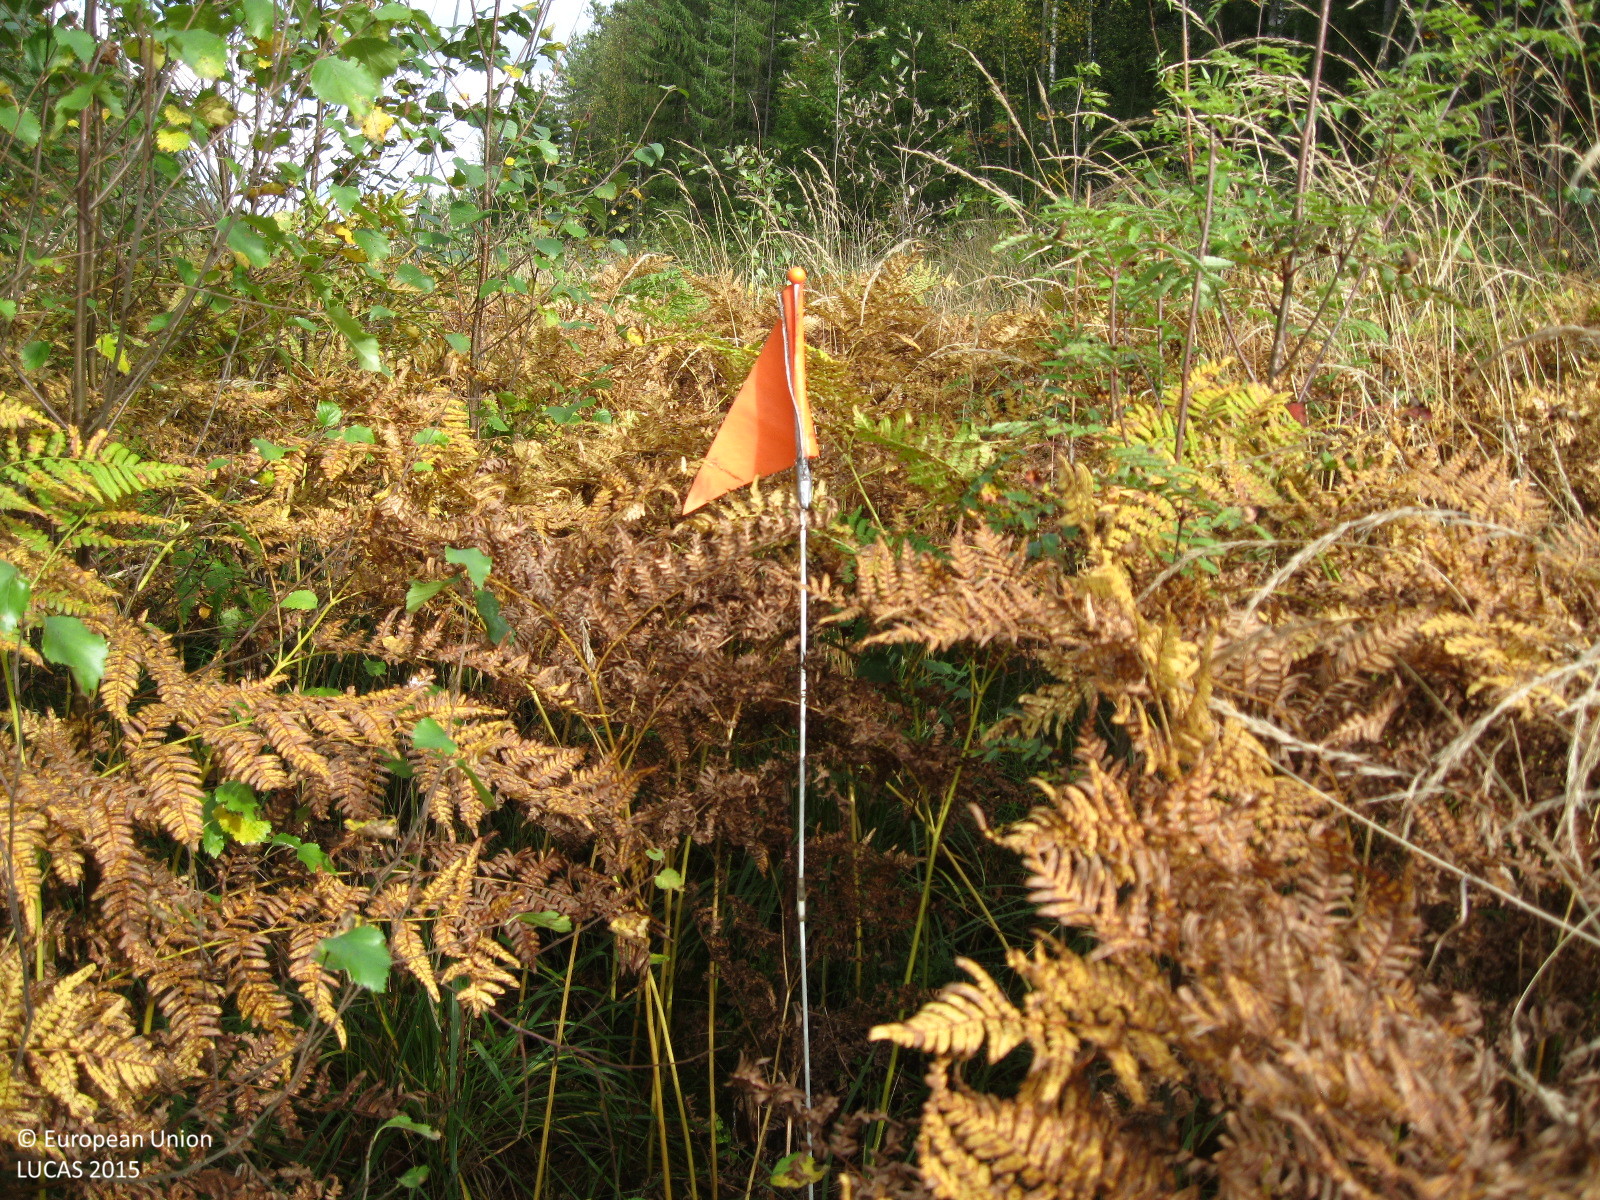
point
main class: Woodland
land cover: Broadleaved woodland
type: boreal forest
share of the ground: 25 - 50 %
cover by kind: herbaceous plants 60 %, broadleaved forest trees 40 %
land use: Electricity, gas and thermal power distribution
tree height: < 5 m
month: September
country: FI
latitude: 60.7134
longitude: 24.8277
